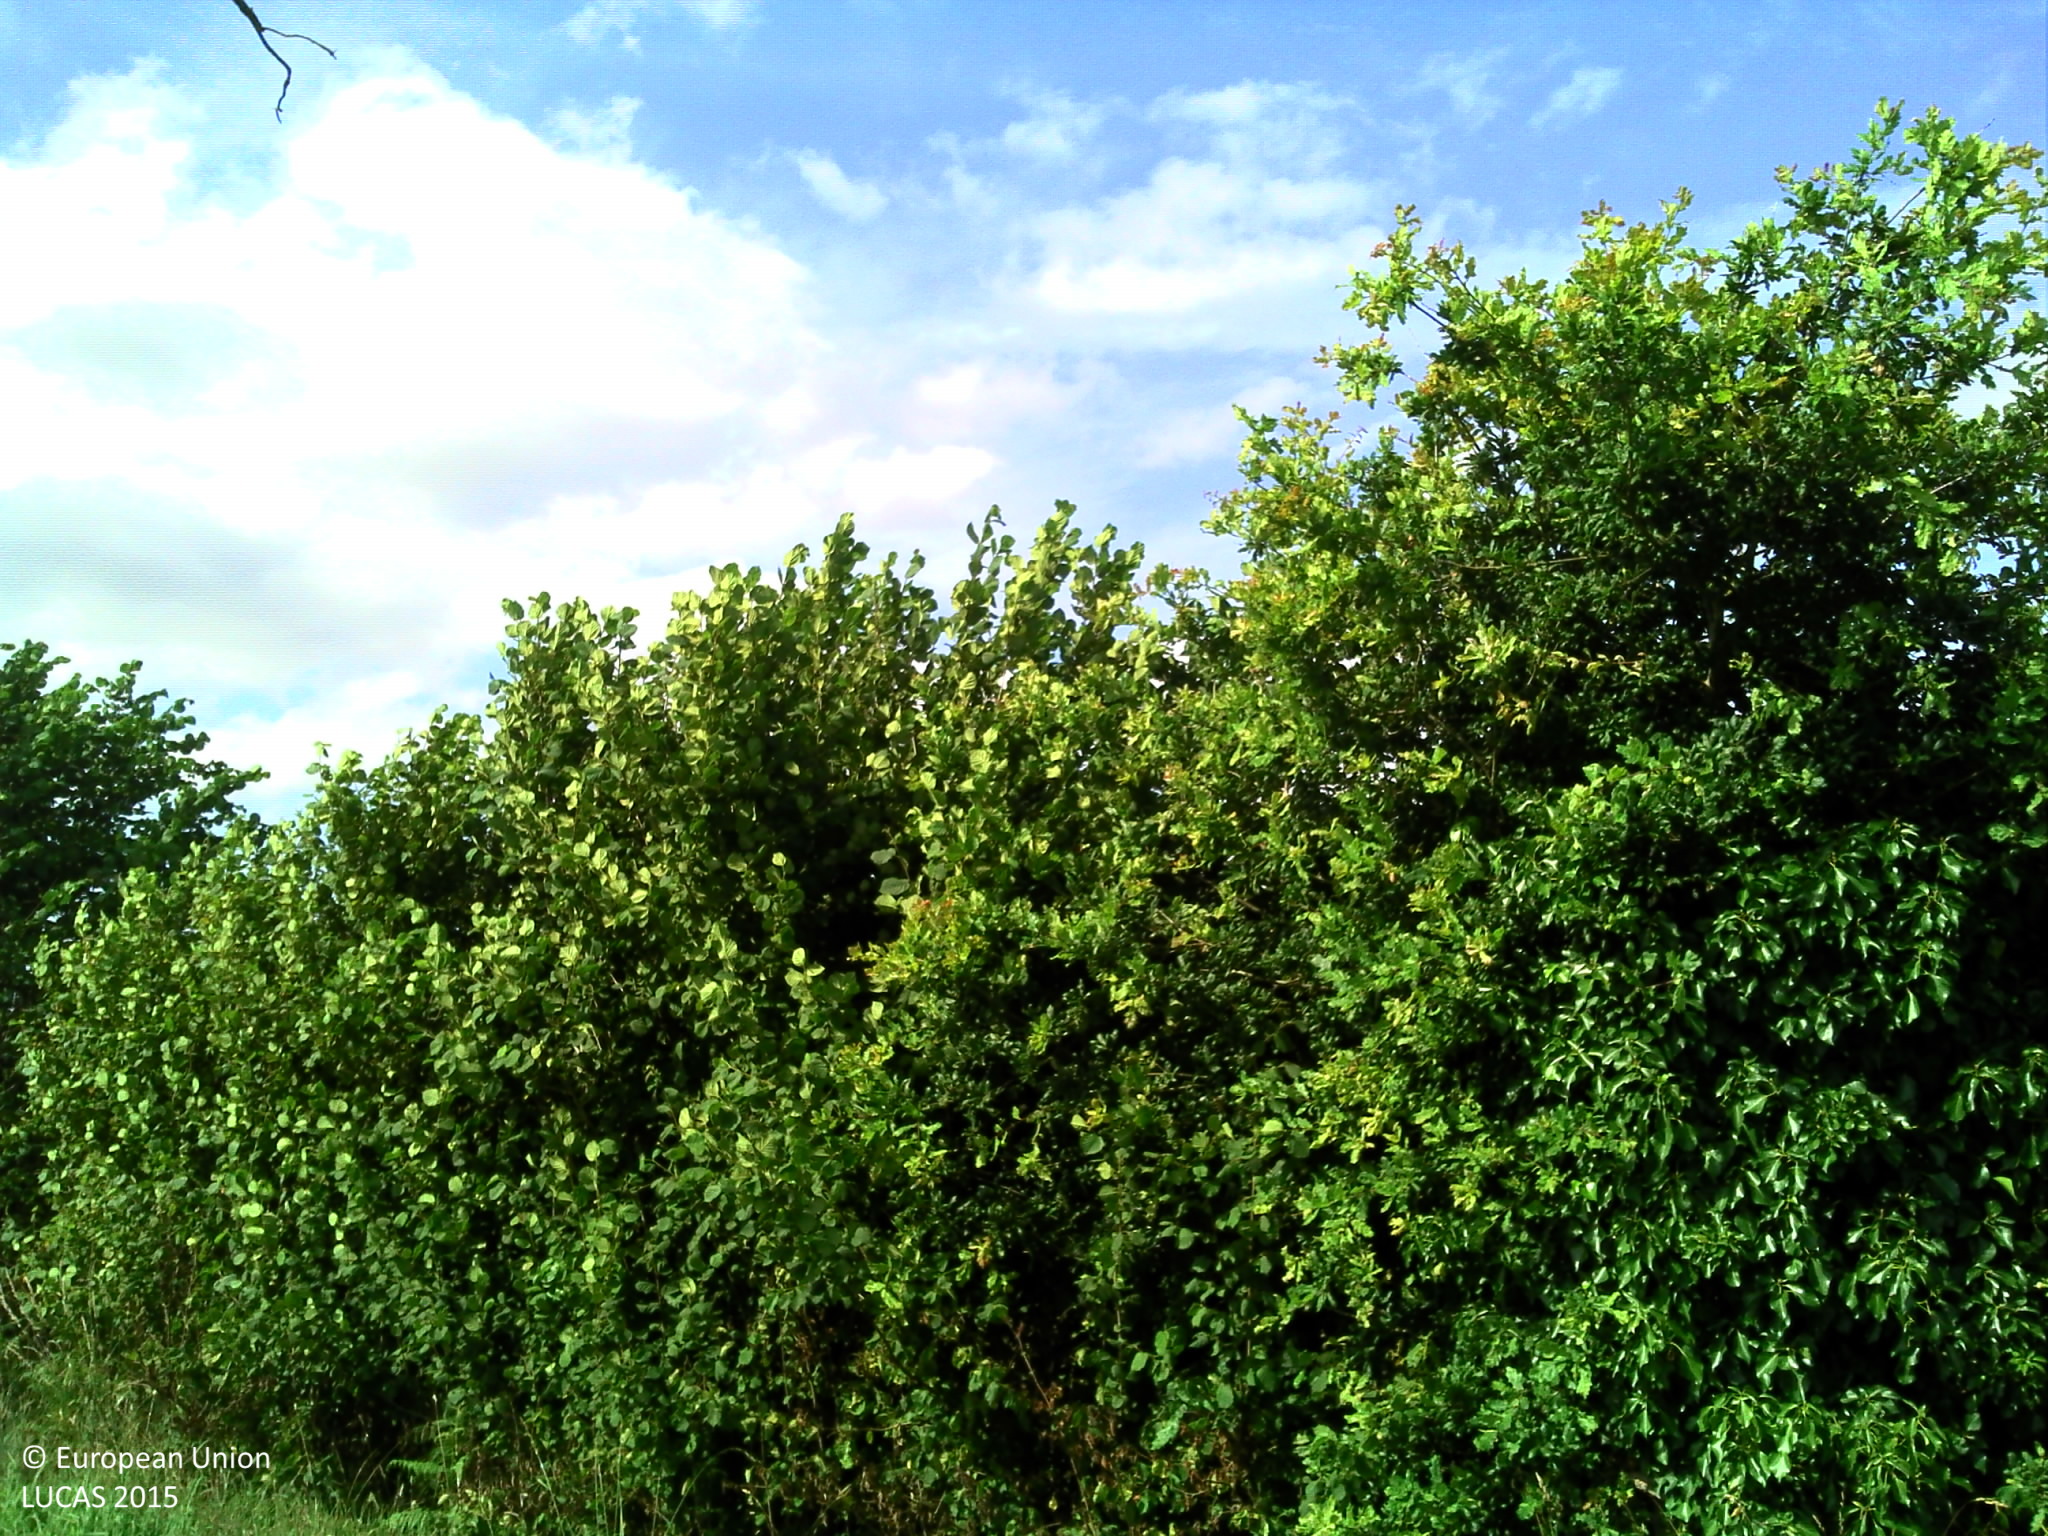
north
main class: Cropland
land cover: Temporary grasslands
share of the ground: > 75 %
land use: Agriculture (excluding fallow land and kitchen gardens)
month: July
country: FR
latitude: 48.2621
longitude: -2.4395
